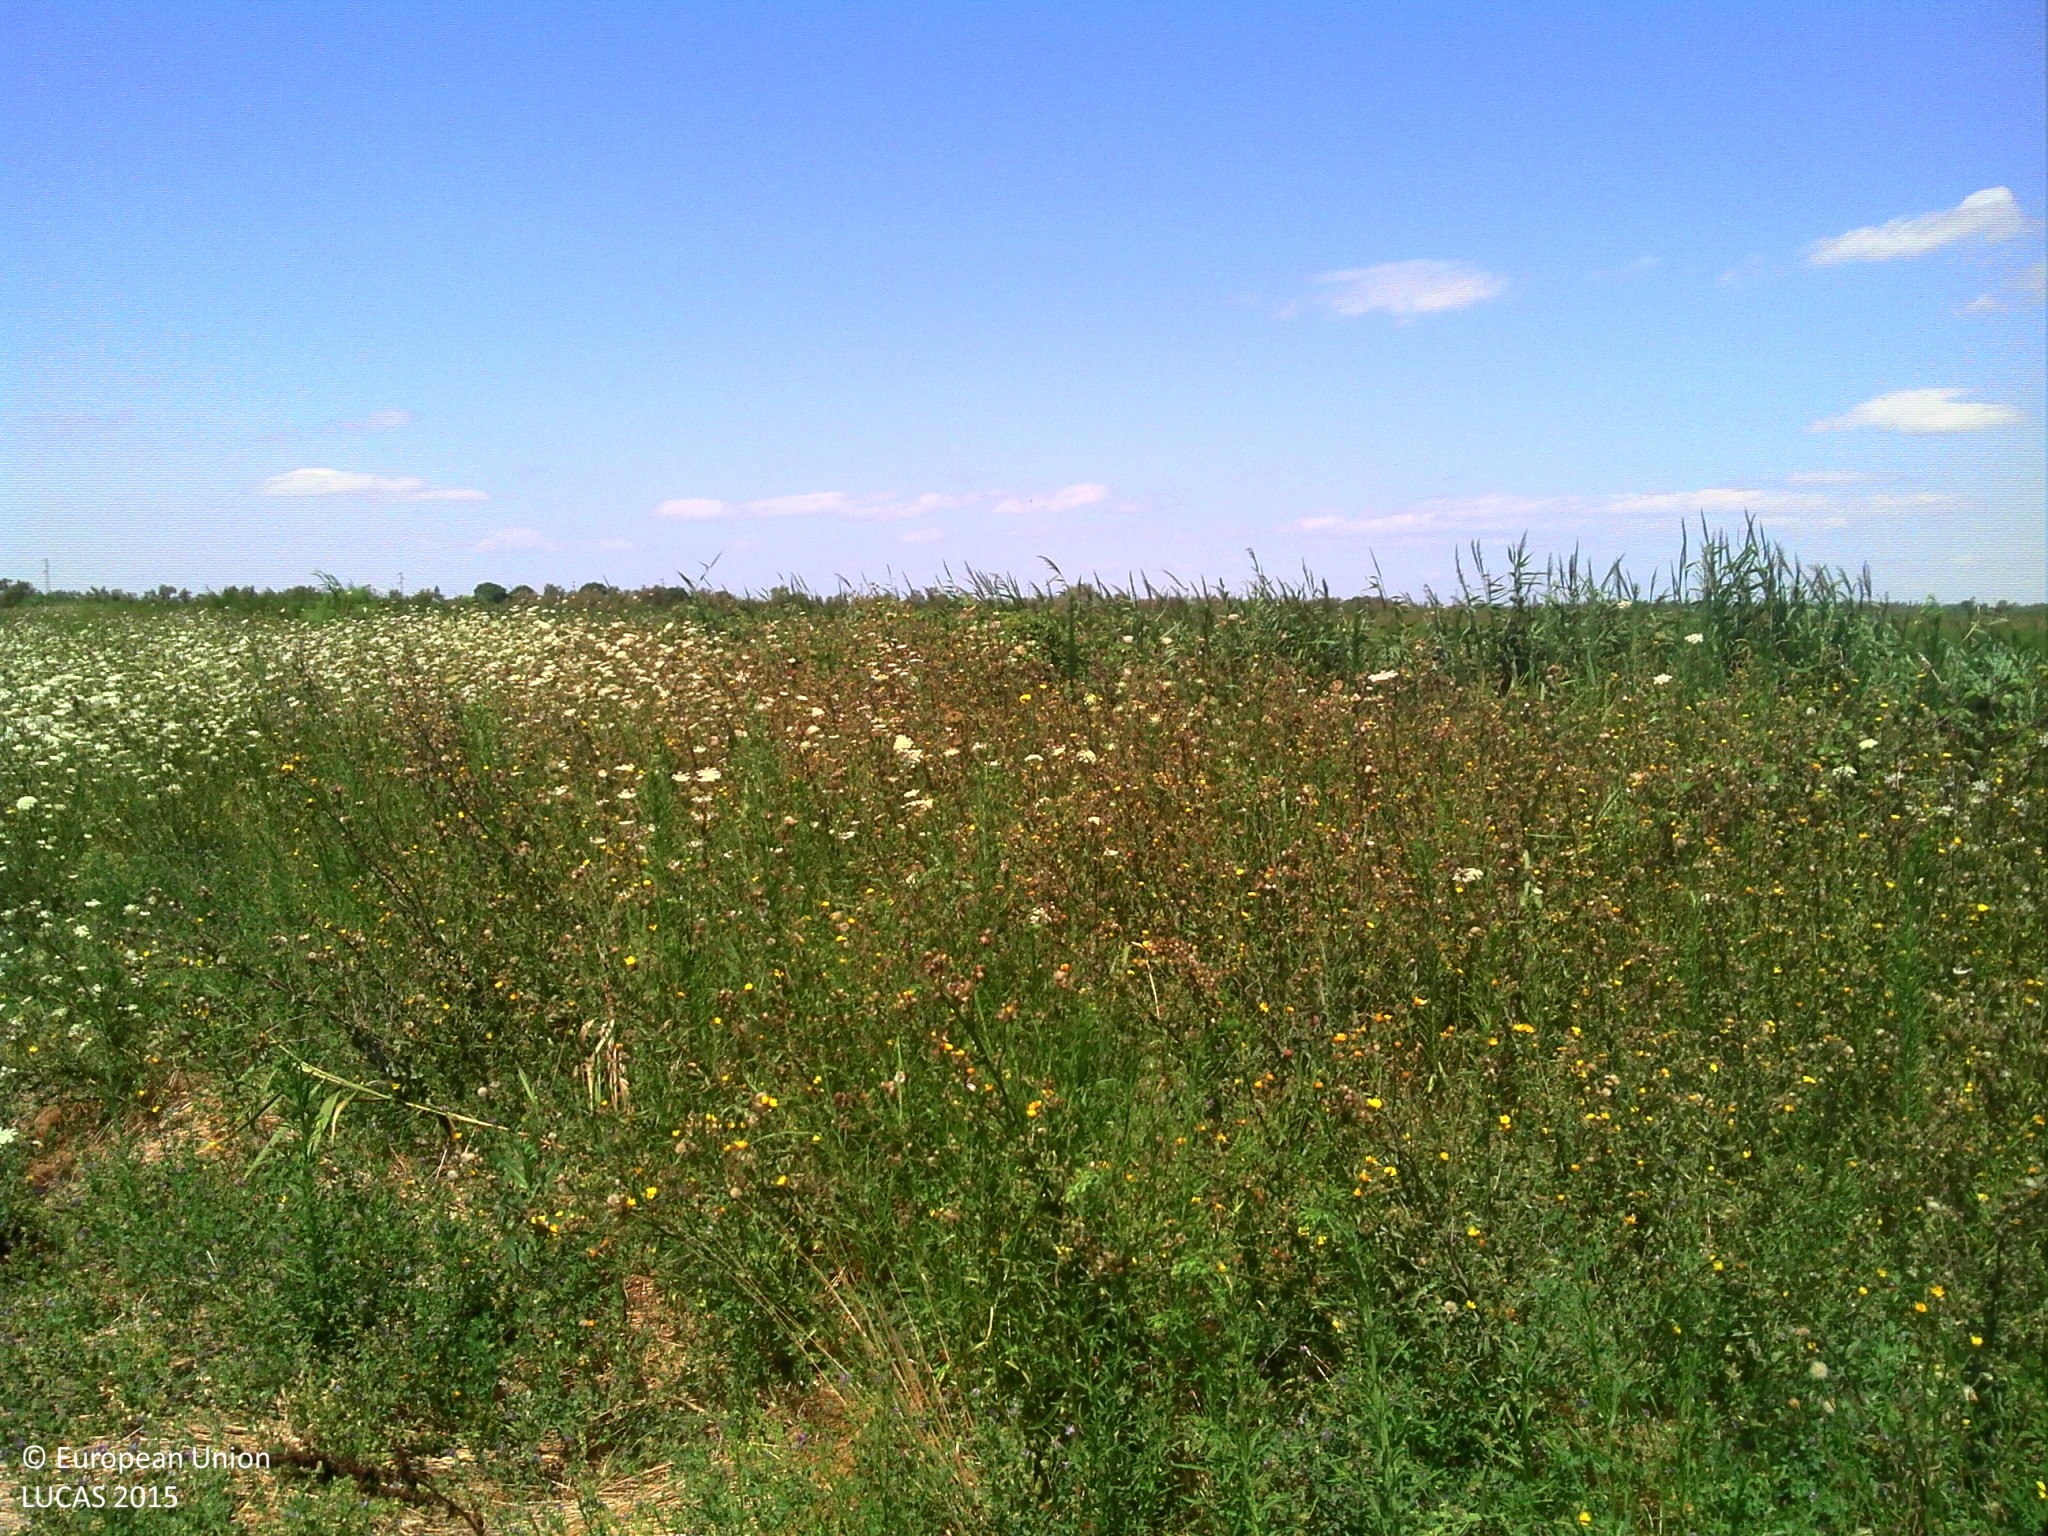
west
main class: Grassland
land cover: Grassland without tree/shrub cover
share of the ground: > 75 %
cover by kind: herbaceous plants 100 %
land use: Agriculture (excluding fallow land and kitchen gardens)
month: July
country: FR
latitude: 43.4743
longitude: 4.7067
